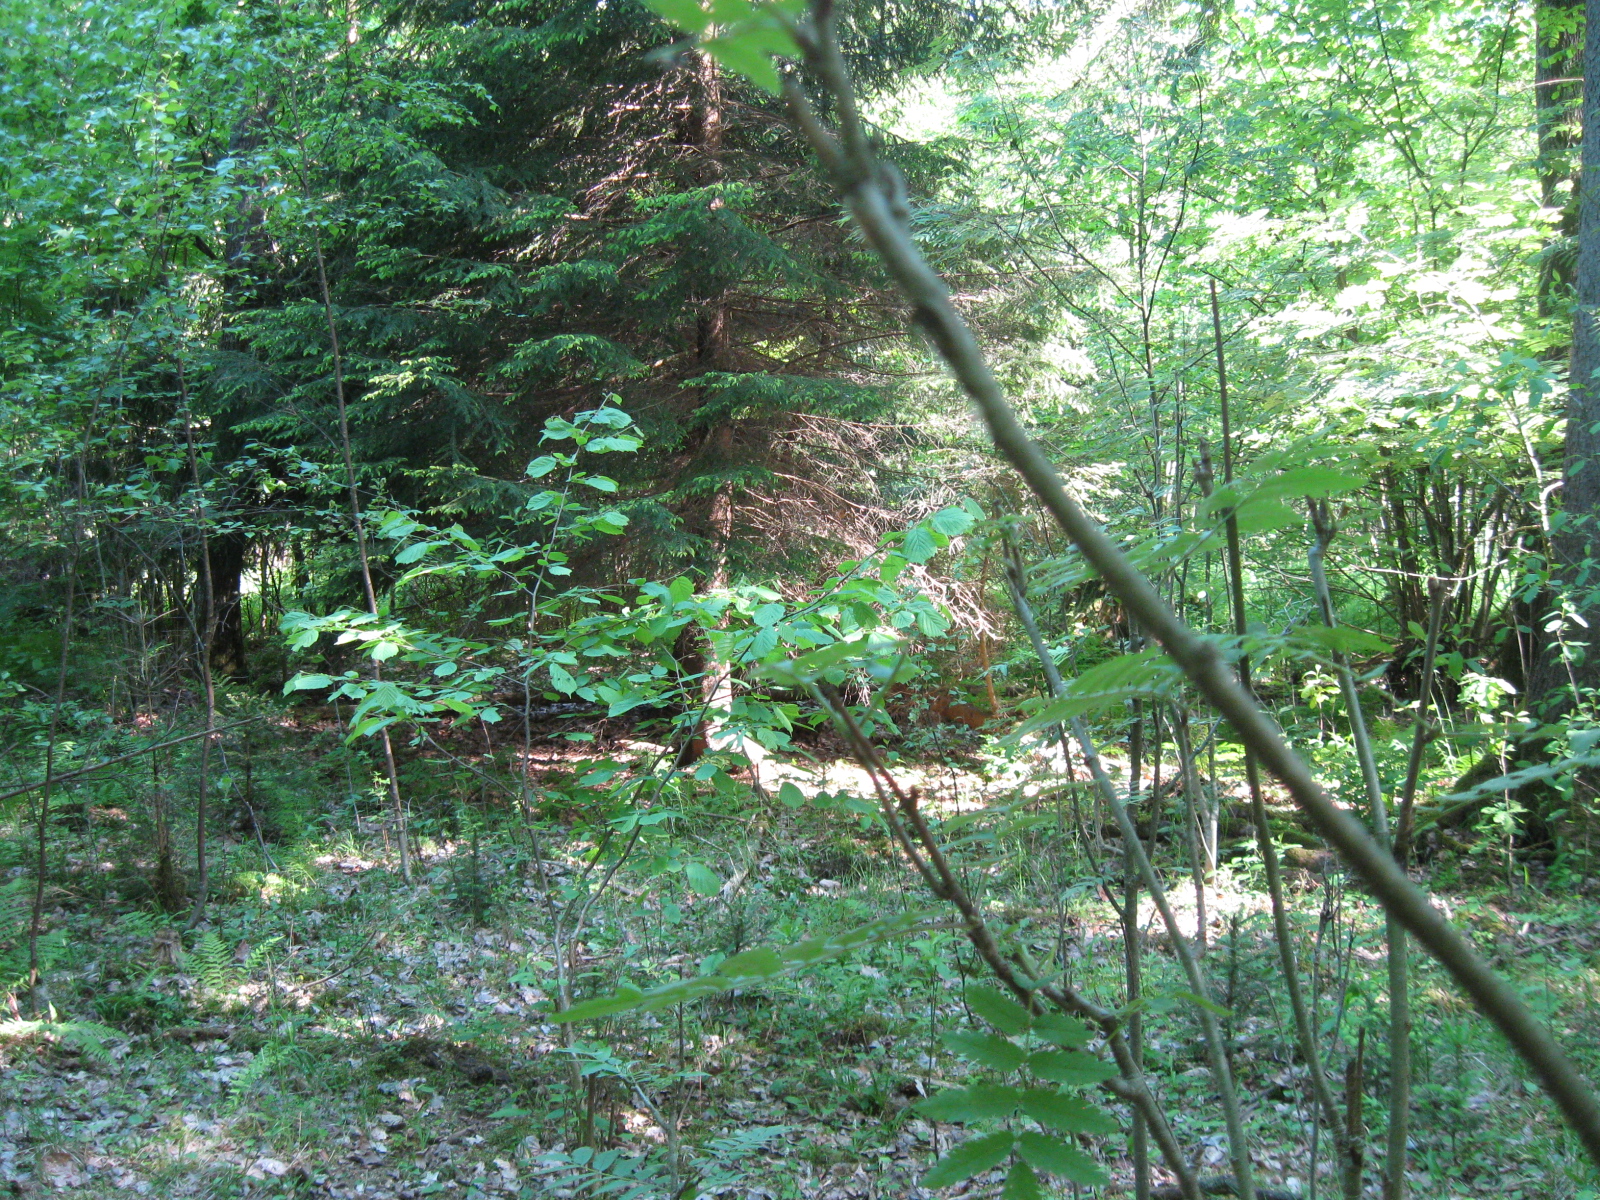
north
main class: Woodland
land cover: Spruce dominated mixed woodland
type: hemiboreal forest and nemoral coniferous forest and mixed broadleaved-coniferous forest
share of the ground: > 75 %
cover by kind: broadleaved forest trees 55 %, coniferous forest trees 40 %, herbaceous plants 5 %
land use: Forestry
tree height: > 5 m
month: June
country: LT
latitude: 54.5565
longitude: 23.8349
